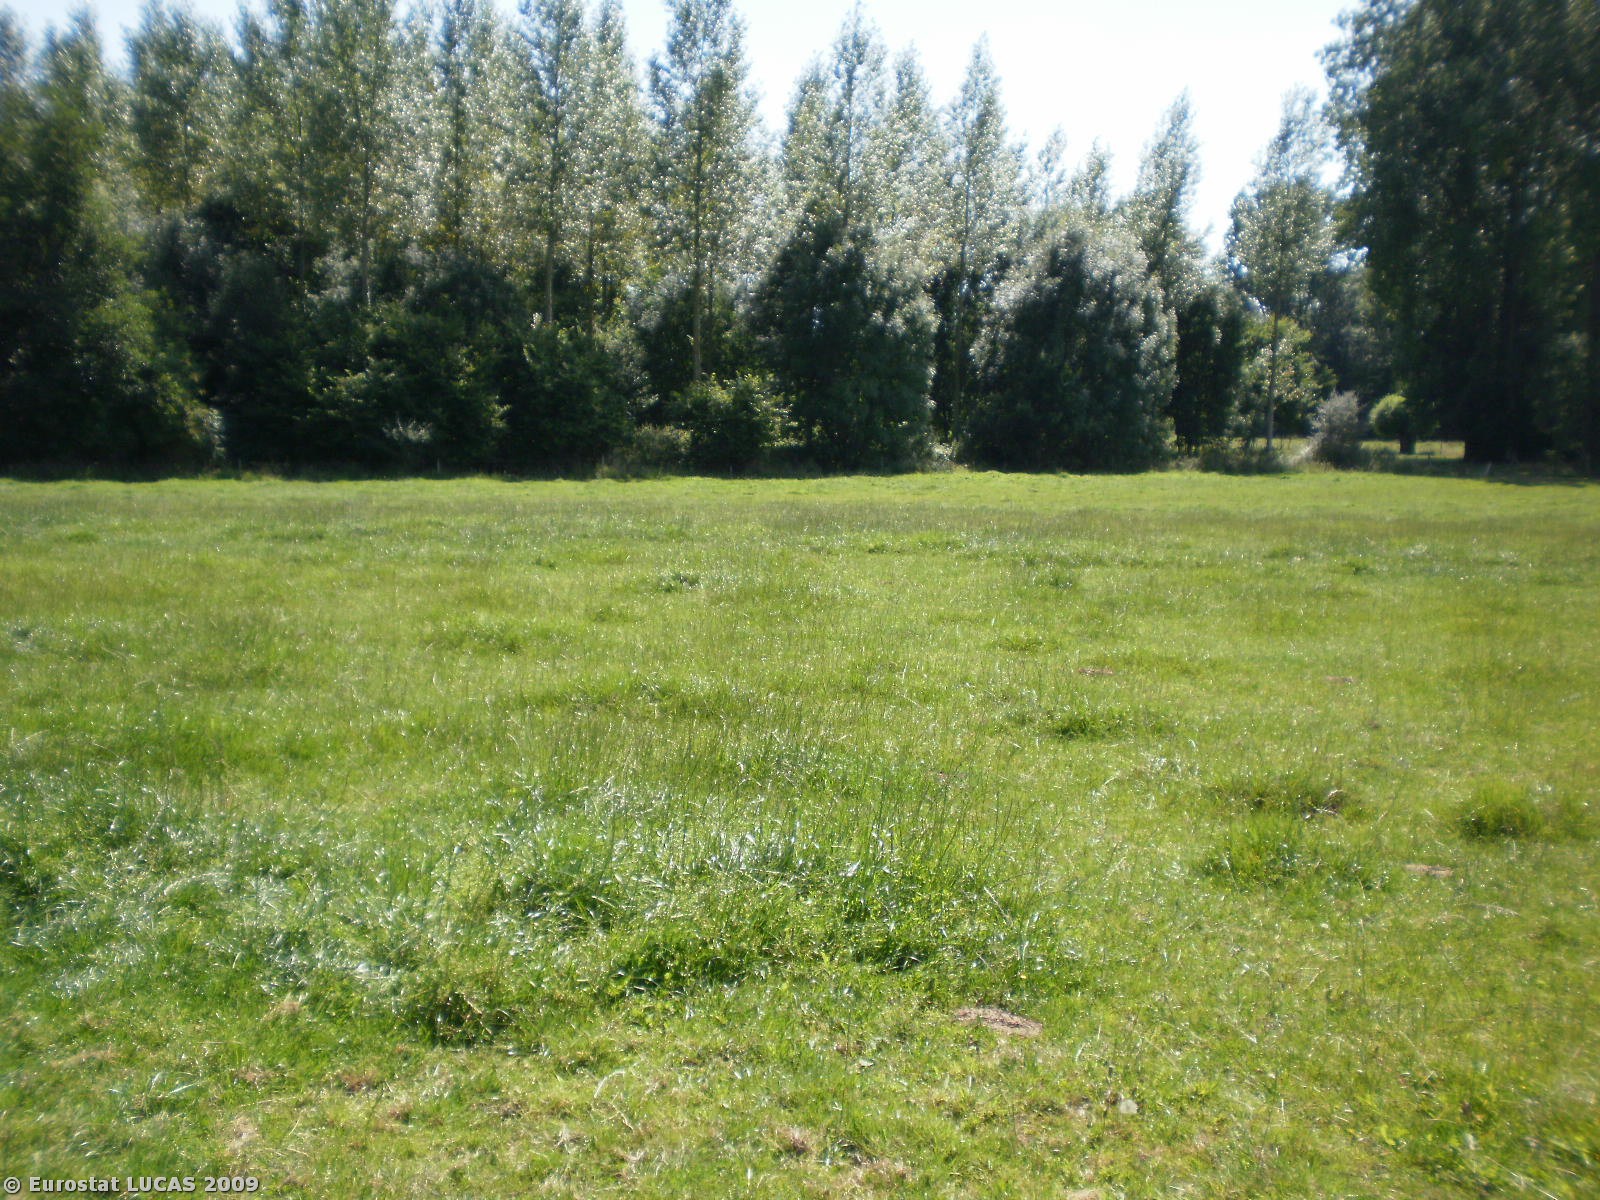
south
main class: Grassland
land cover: Grassland without tree/shrub cover
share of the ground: > 75 %
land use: Agriculture (excluding fallow land and kitchen gardens)
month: August
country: BE
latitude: 50.7907
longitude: 3.7942
